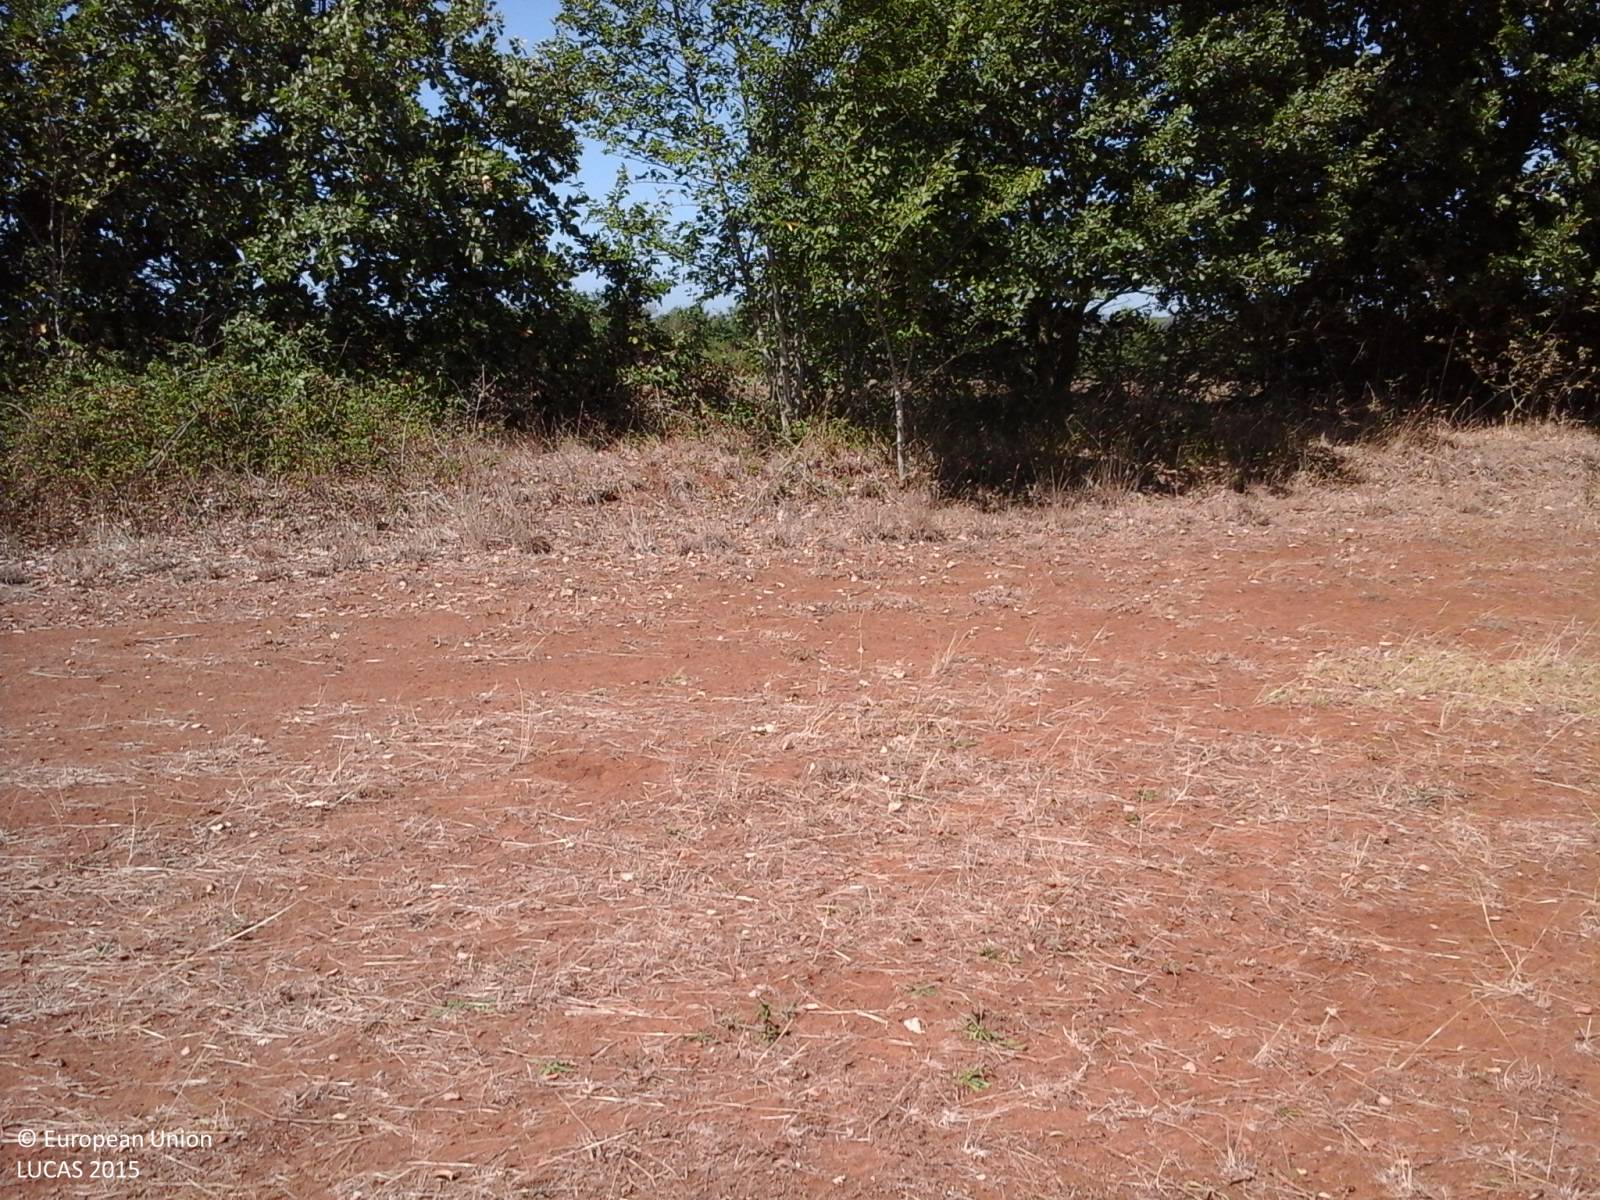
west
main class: Grassland
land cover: Spontaneously vegetated surfaces
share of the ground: > 75 %
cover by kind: herbaceous plants 85 %, consolidated bare surface 15 %
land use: Agriculture (excluding fallow land and kitchen gardens)
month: July
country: IT
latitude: 42.1930
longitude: 12.3530
